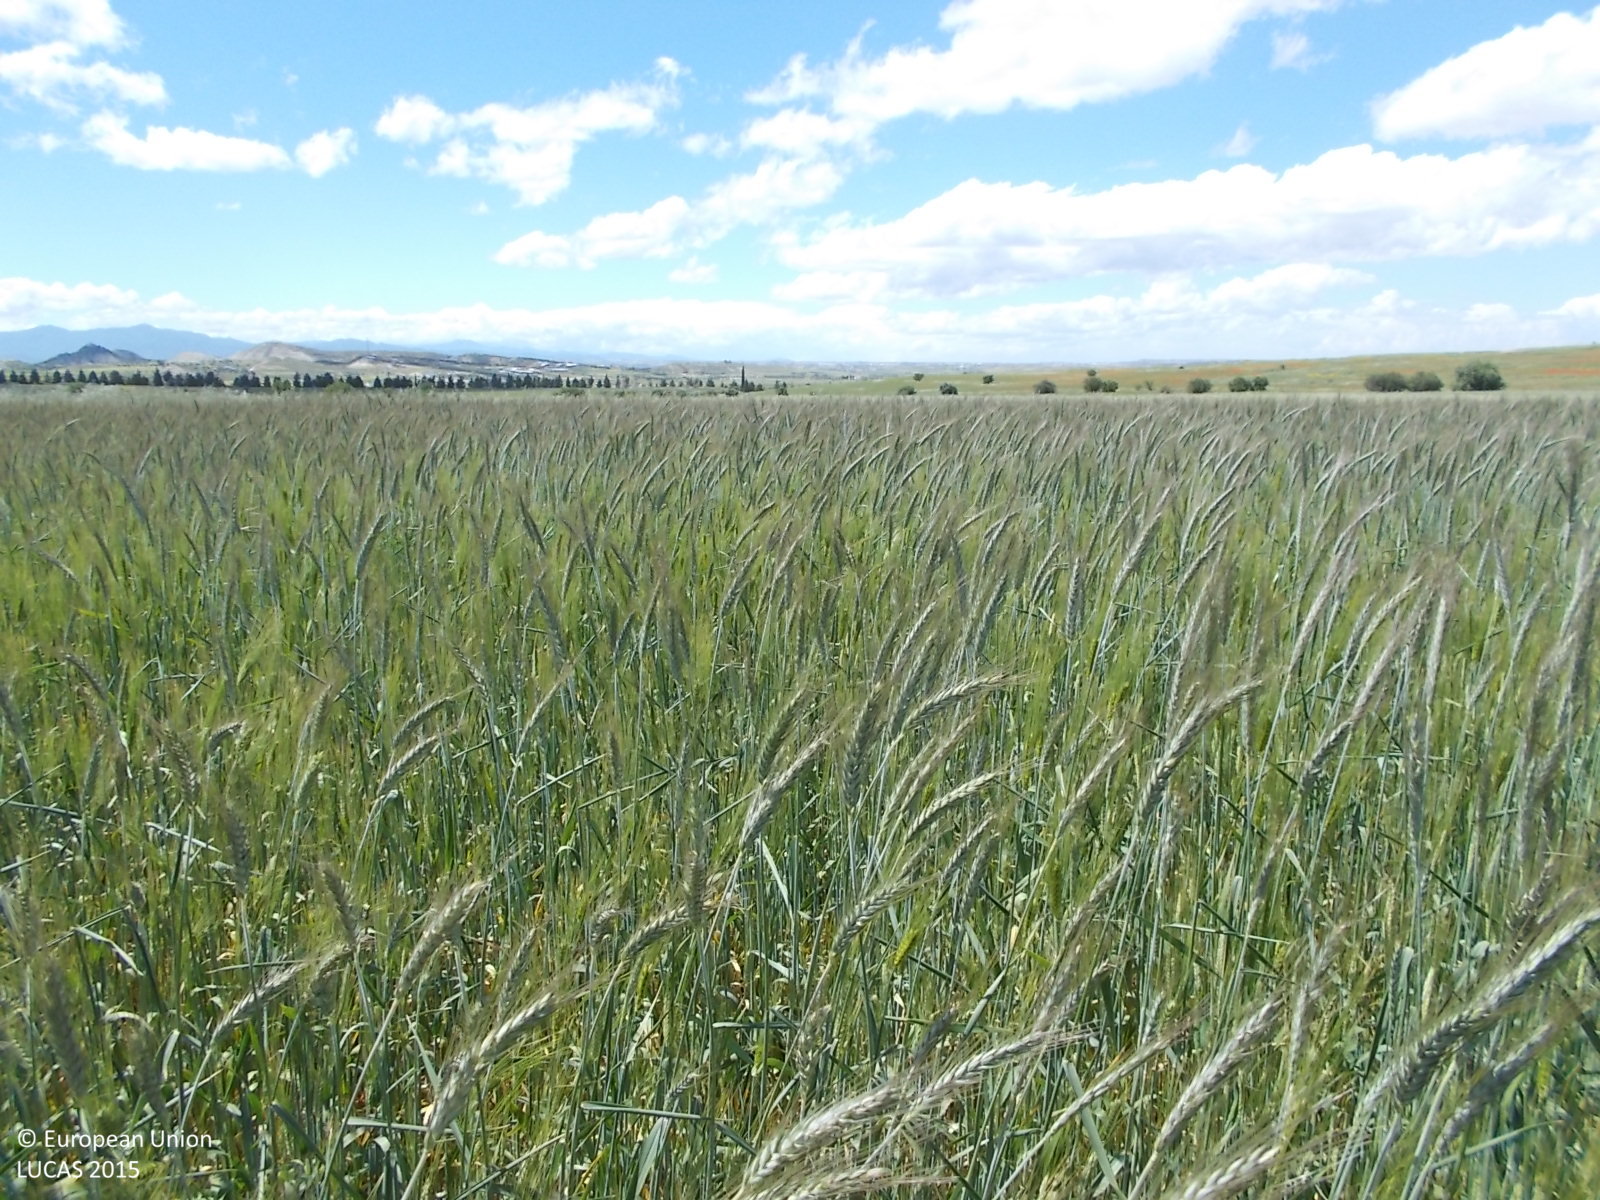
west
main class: Cropland
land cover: Mixed cereals for fodder
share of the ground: > 75 %
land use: Agriculture (excluding fallow land and kitchen gardens)
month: April
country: CY
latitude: 35.0199
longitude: 33.5055
